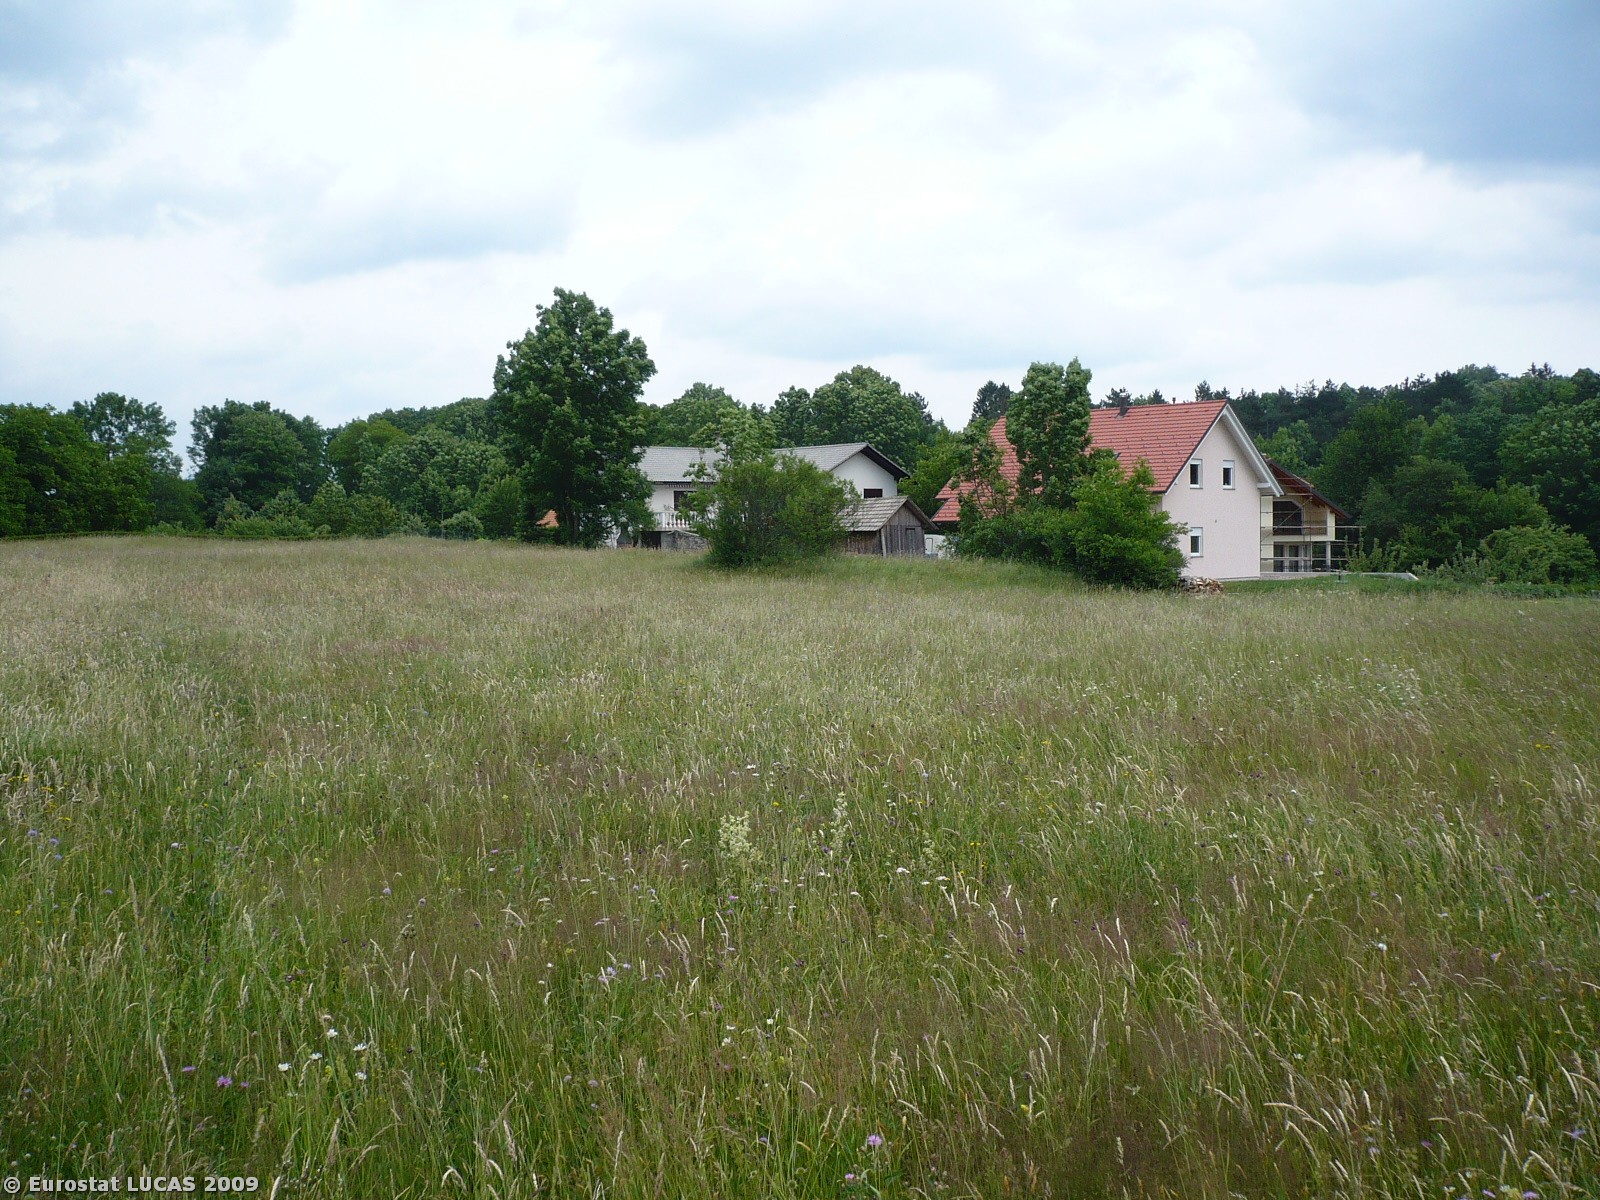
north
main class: Grassland
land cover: Grassland without tree/shrub cover
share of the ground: > 75 %
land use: Agriculture (excluding fallow land and kitchen gardens)
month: June
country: SI
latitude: 45.7457
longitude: 14.1989
